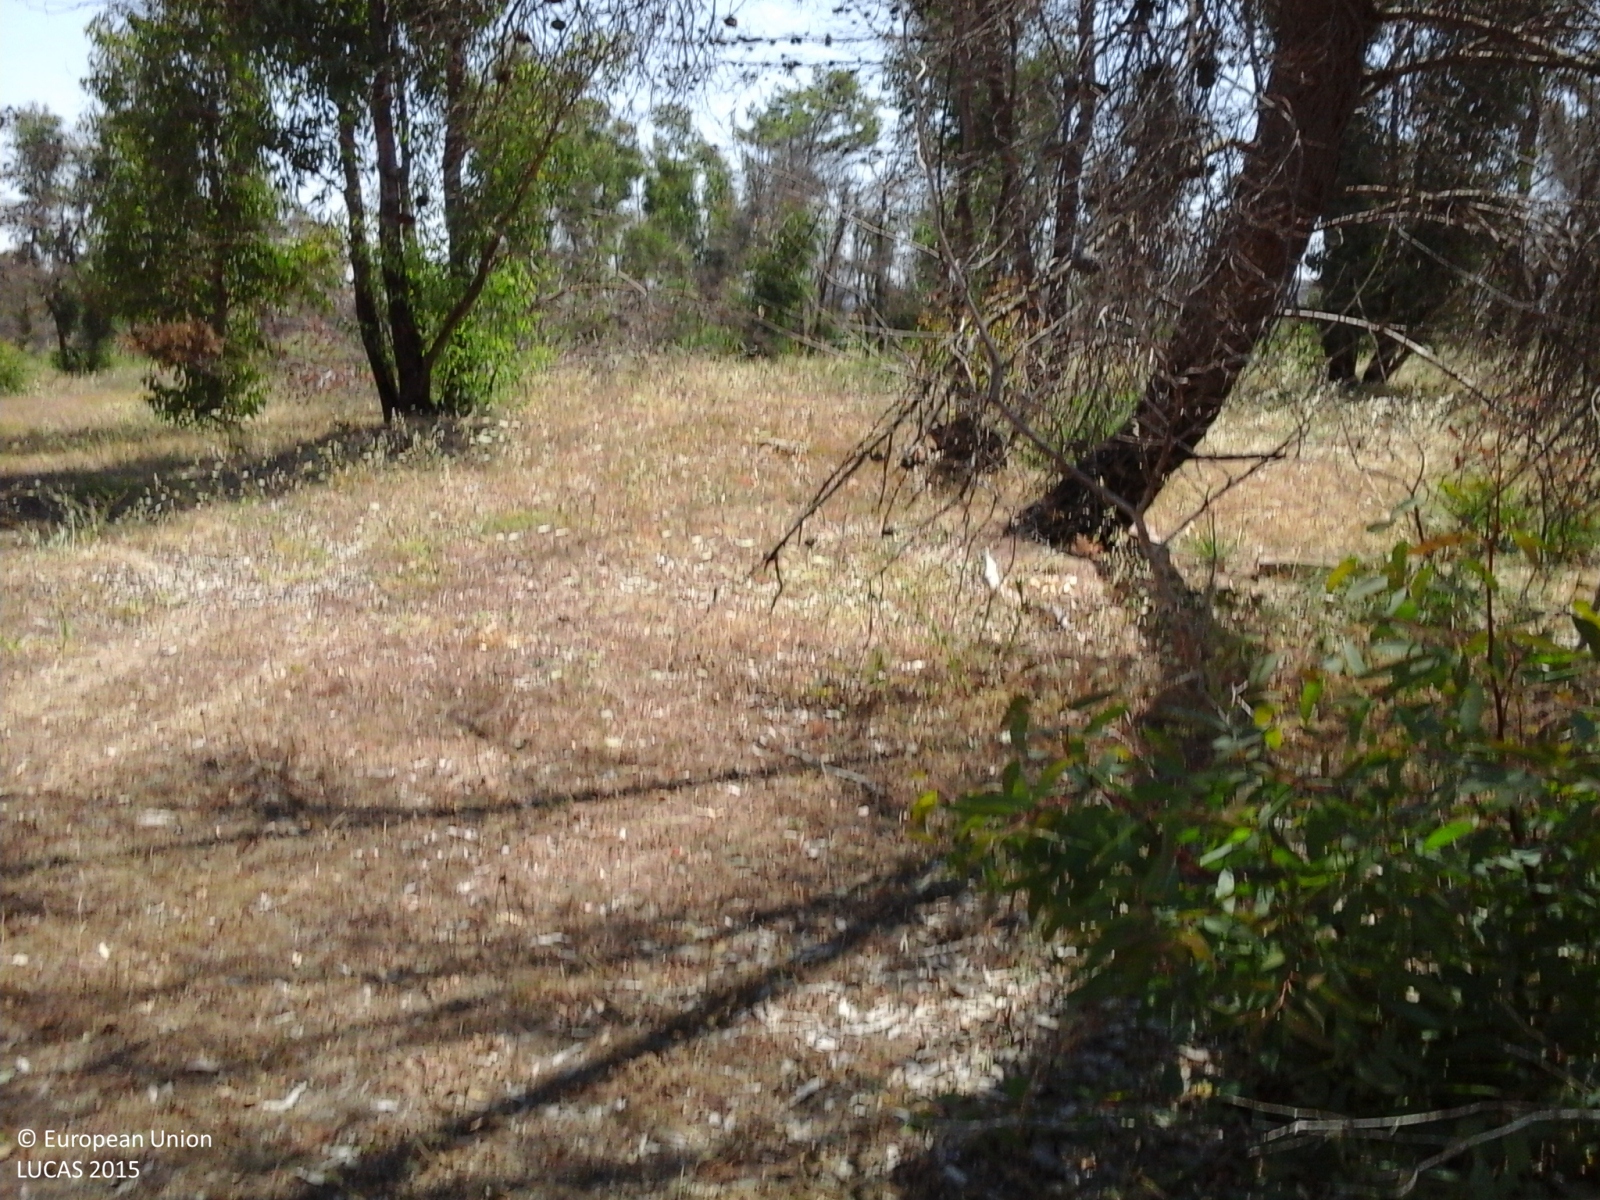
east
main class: Woodland
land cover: Other mixed woodland
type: exotic forest
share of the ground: > 75 %
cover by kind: broadleaved forest trees 60 %, coniferous forest trees 30 %, herbaceous plants 10 %
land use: Forestry
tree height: > 5 m
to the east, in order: Other mixed woodland; Tracks; Electric lines; Other mixed woodland
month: July
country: IT
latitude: 37.2852
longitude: 14.3320
